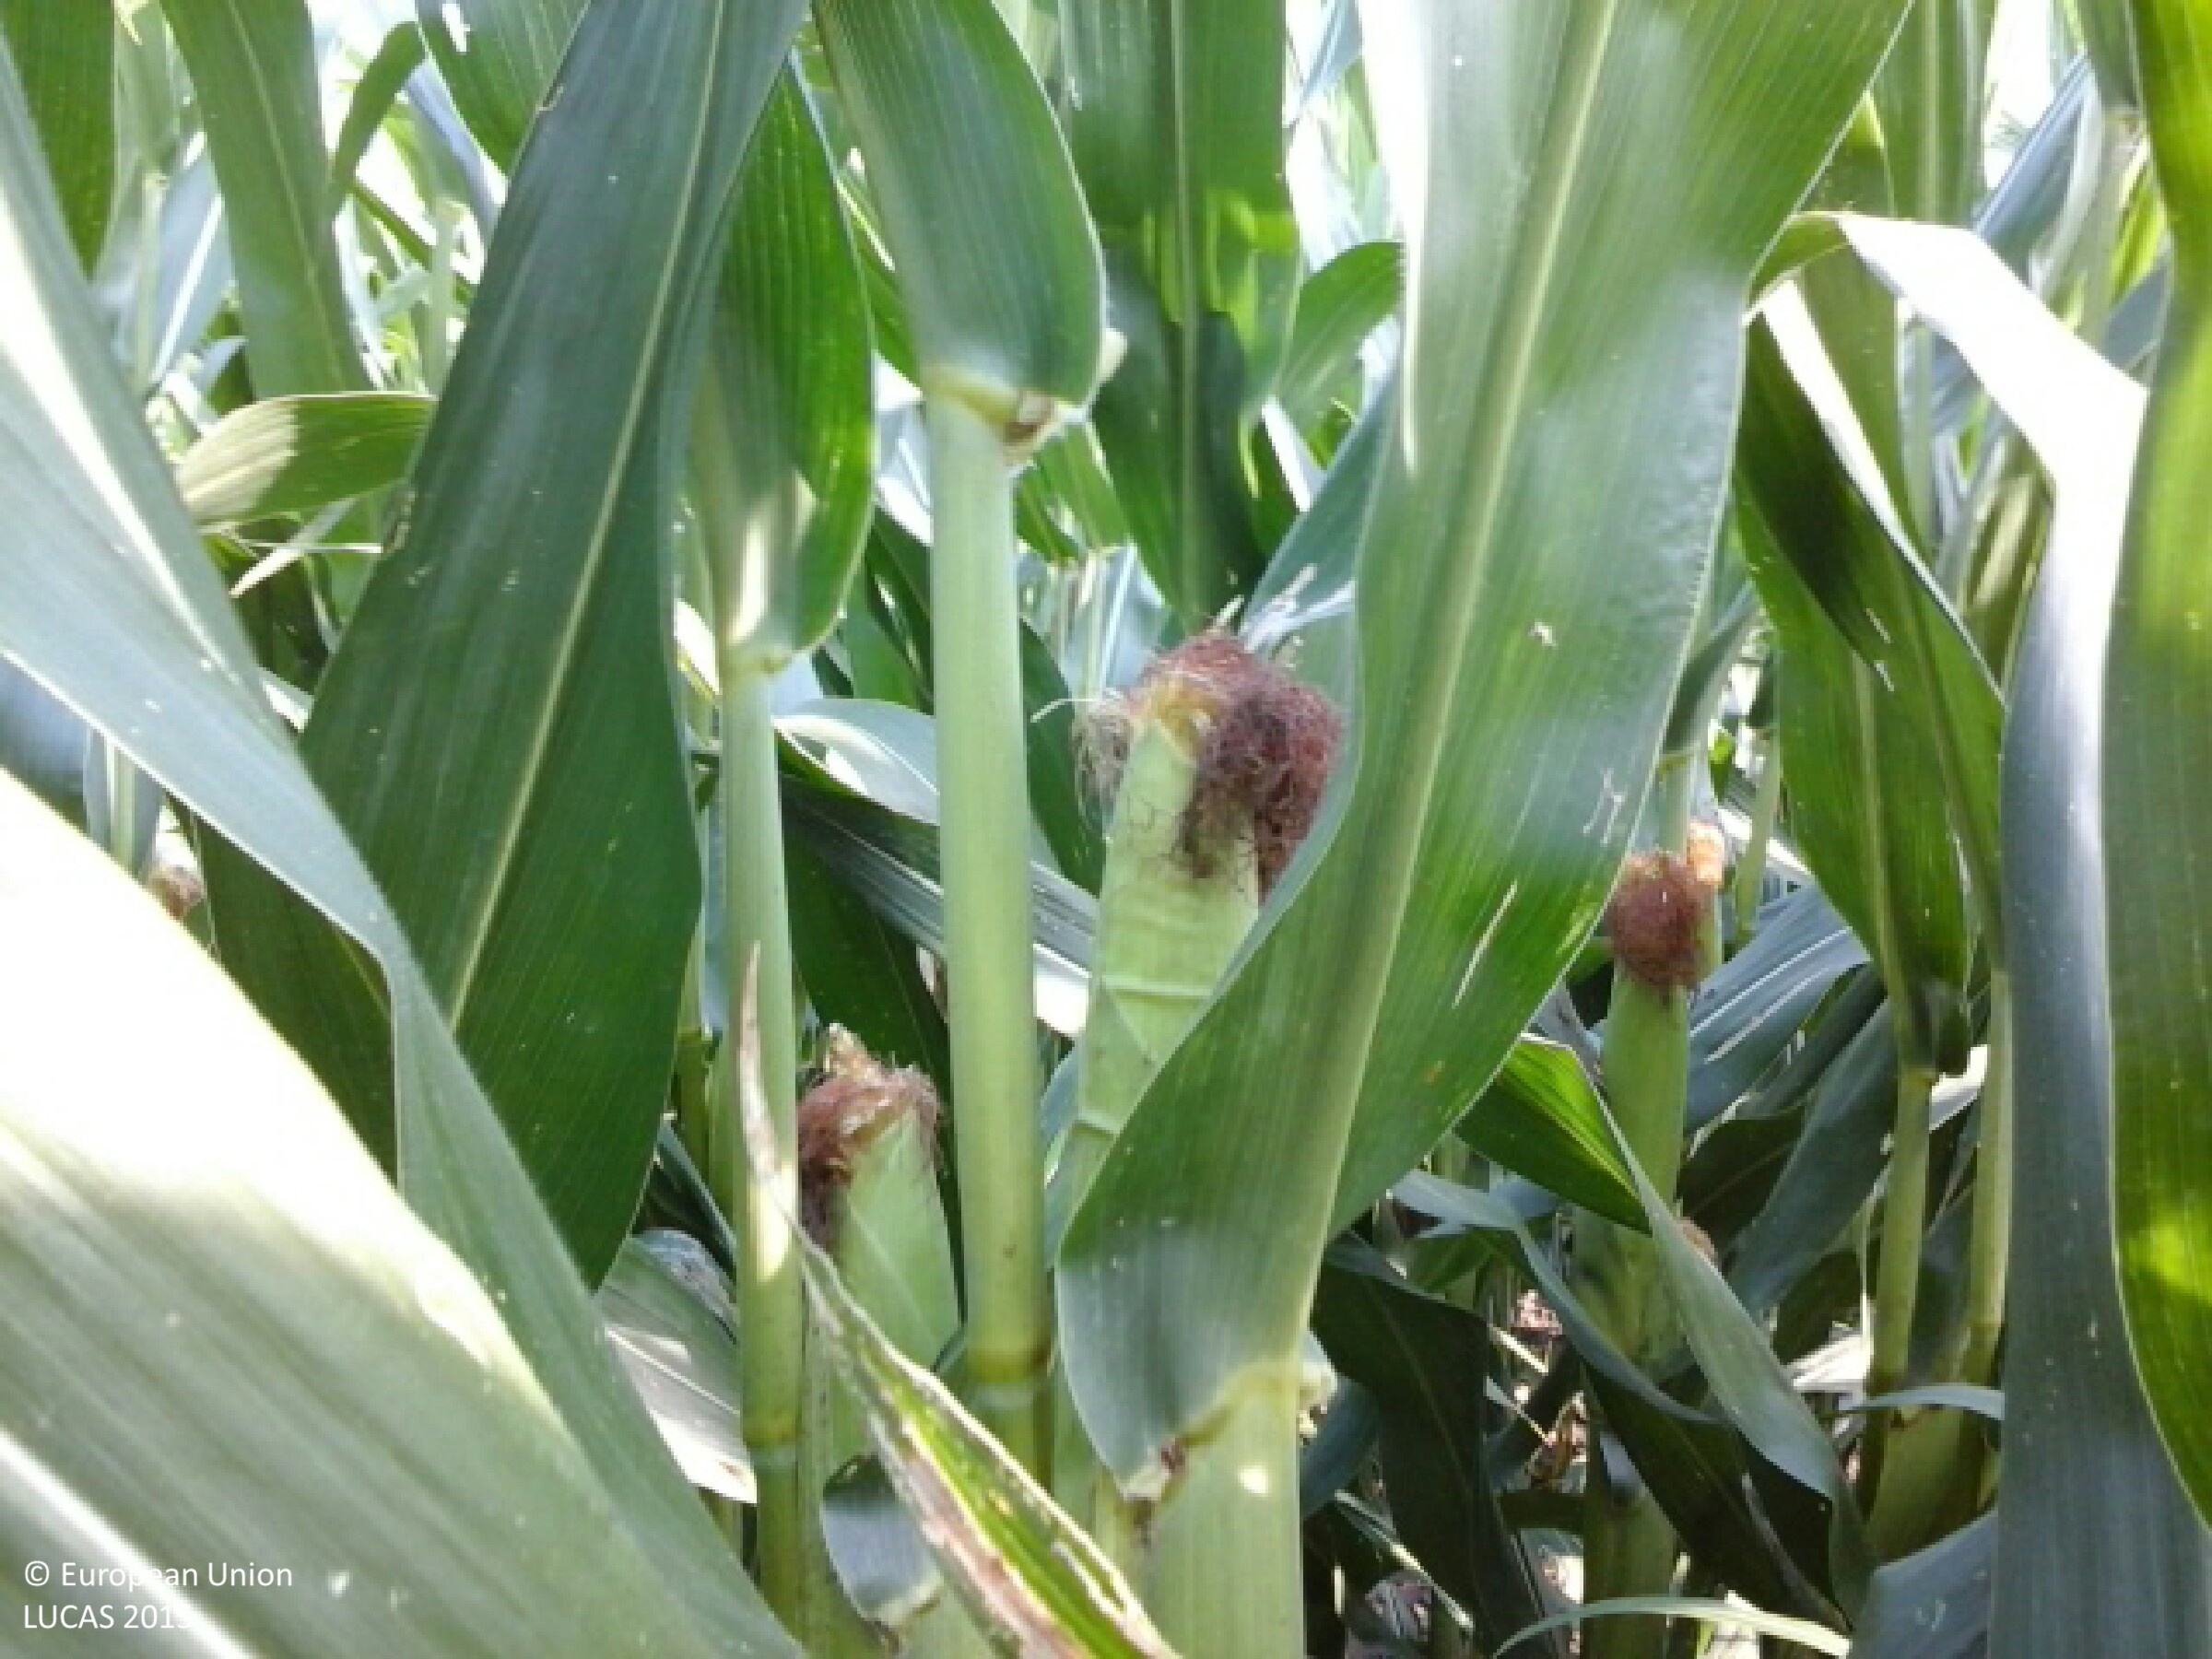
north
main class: Cropland
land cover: Maize
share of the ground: > 75 %
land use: Agriculture (excluding fallow land and kitchen gardens)
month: August
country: HU
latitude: 47.6839
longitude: 17.9373
